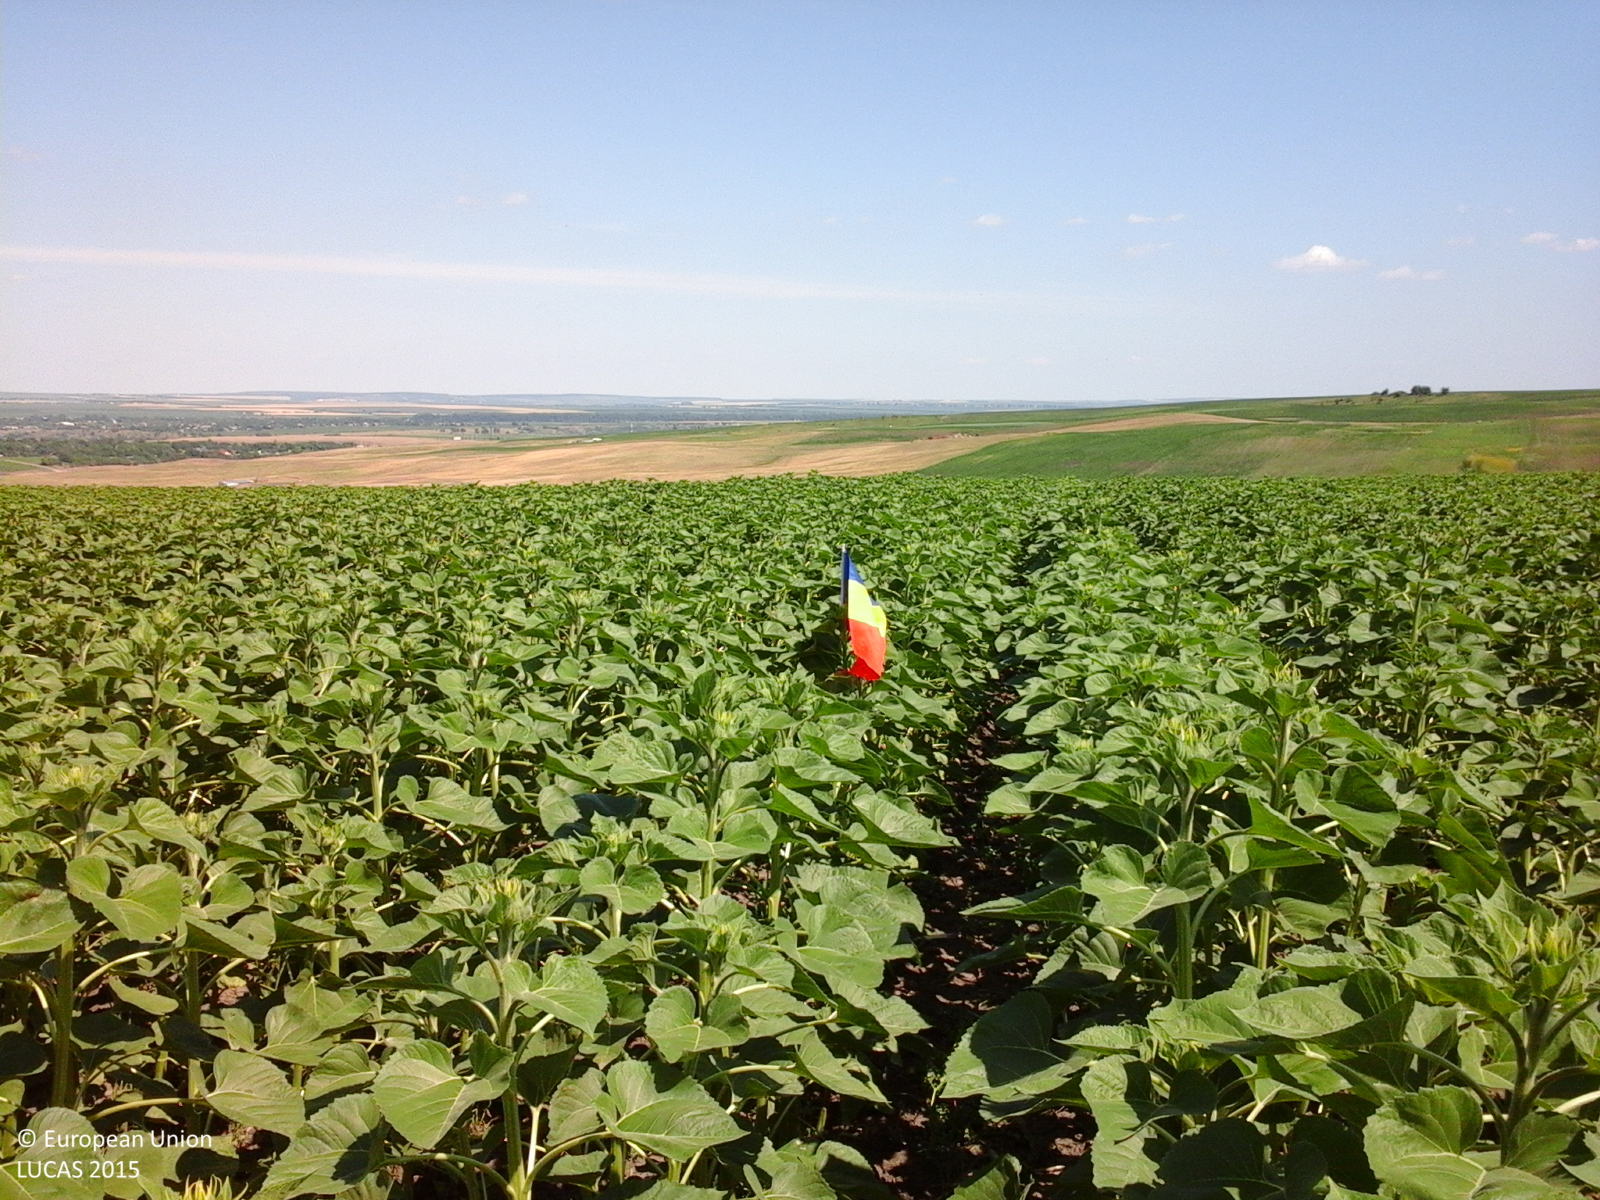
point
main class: Cropland
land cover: Sunflower
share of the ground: > 75 %
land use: Agriculture (excluding fallow land and kitchen gardens)
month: June
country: RO
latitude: 48.0881
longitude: 26.9822
